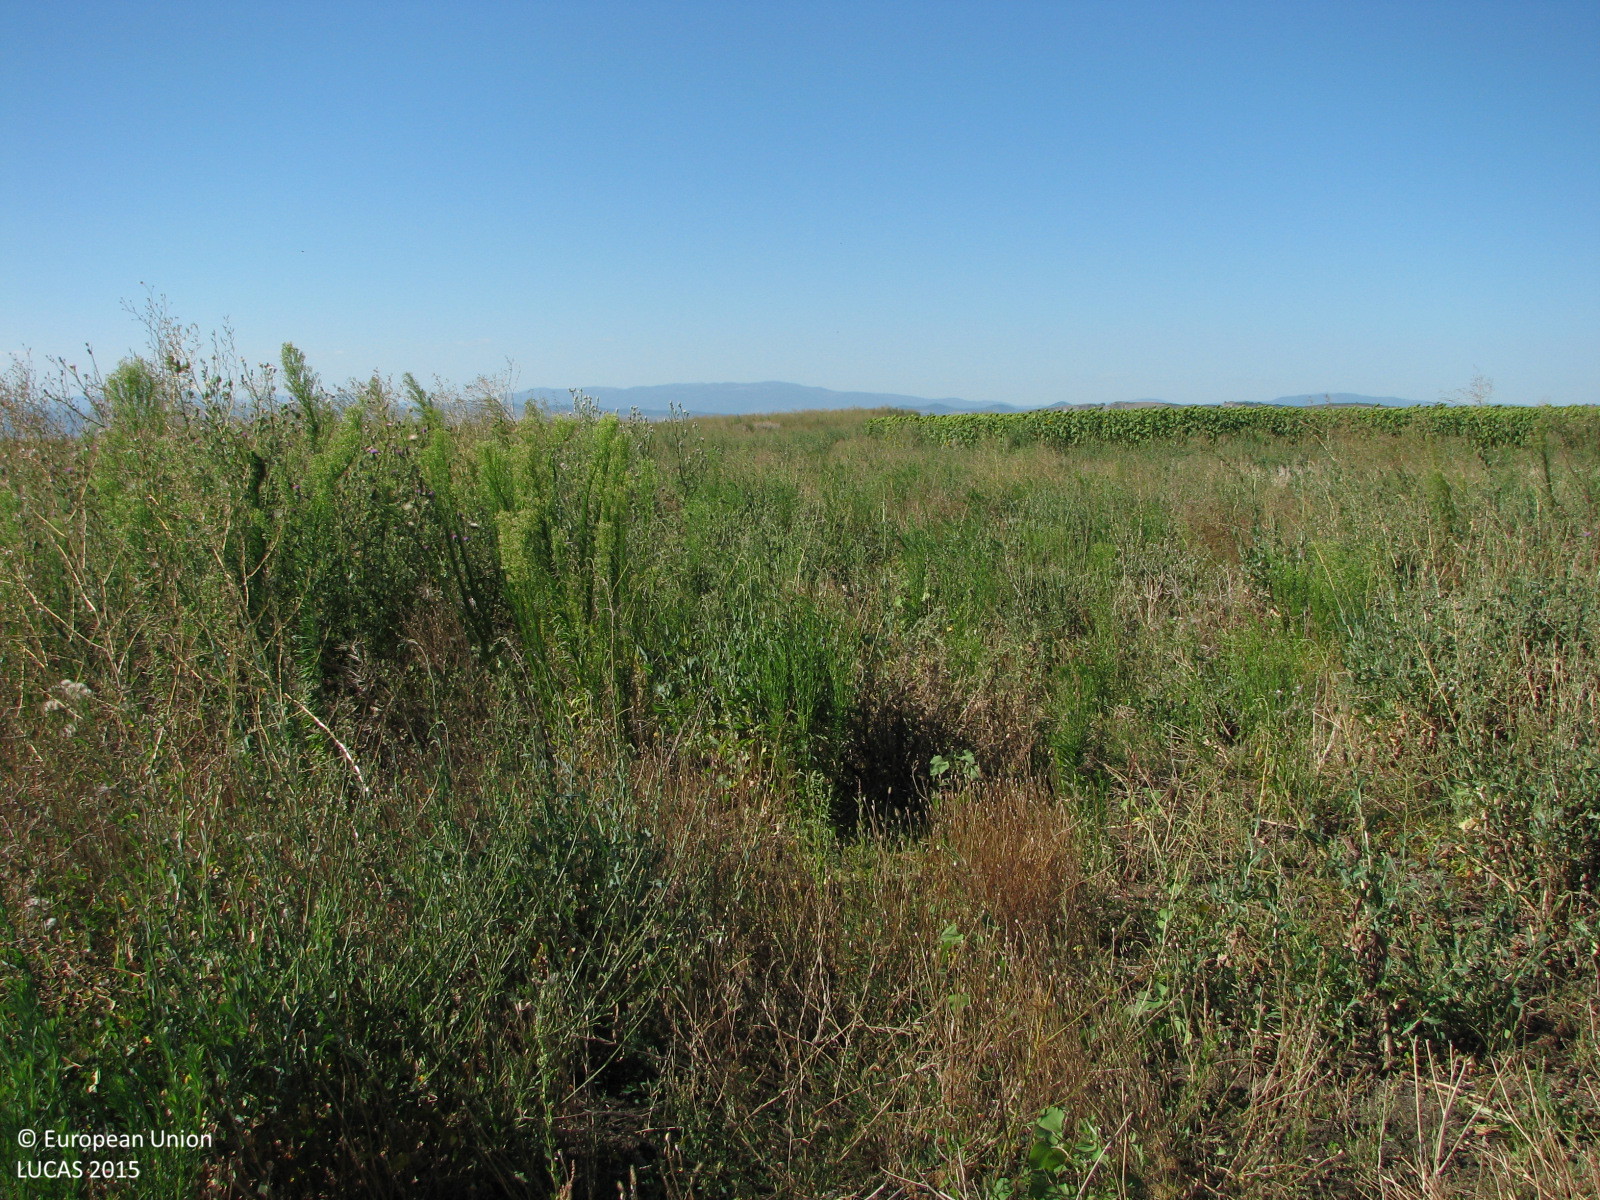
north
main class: Grassland
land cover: Spontaneously vegetated surfaces
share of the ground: > 75 %
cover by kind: herbaceous plants 100 %
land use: Fallow land
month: July
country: BG
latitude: 42.3788
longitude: 26.0264
